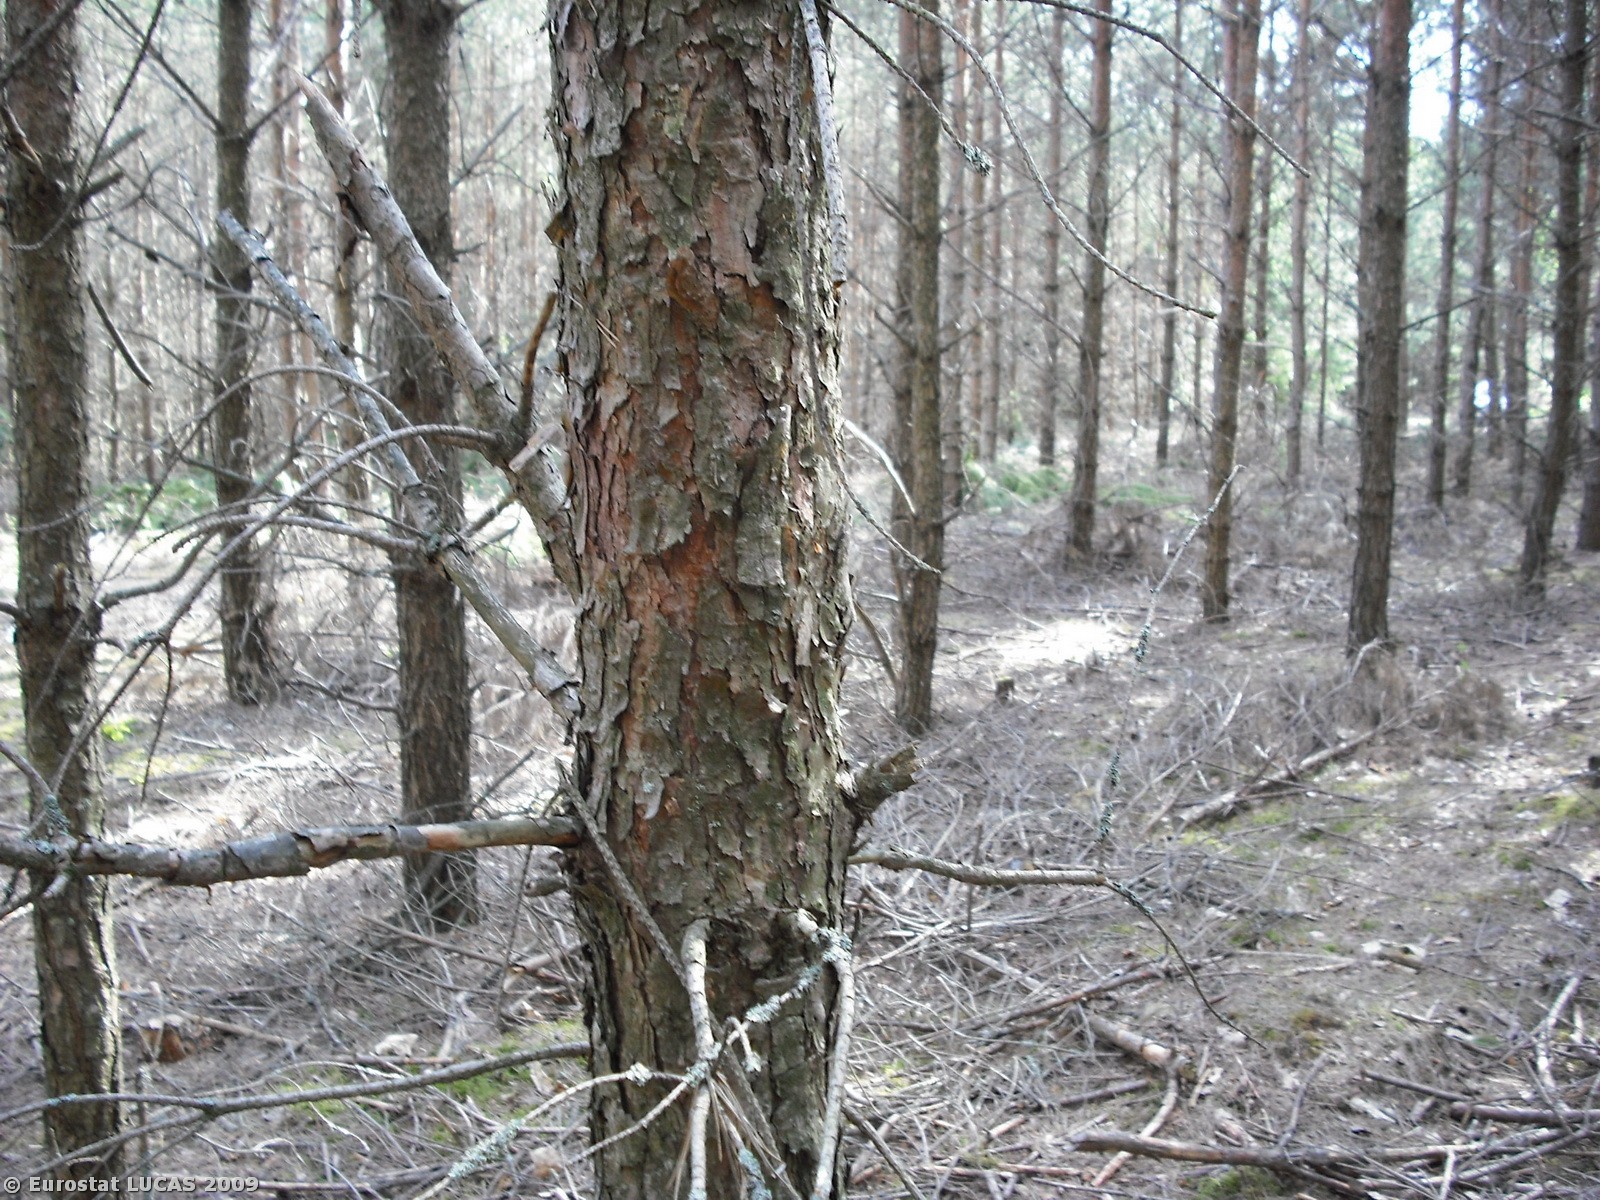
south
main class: Woodland
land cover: Coniferous woodland
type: hemiboreal forest and nemoral coniferous forest and mixed broadleaved-coniferous forest
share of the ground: > 75 %
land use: Forestry
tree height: > 5 m
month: May
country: PL
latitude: 53.0687
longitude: 23.5923
